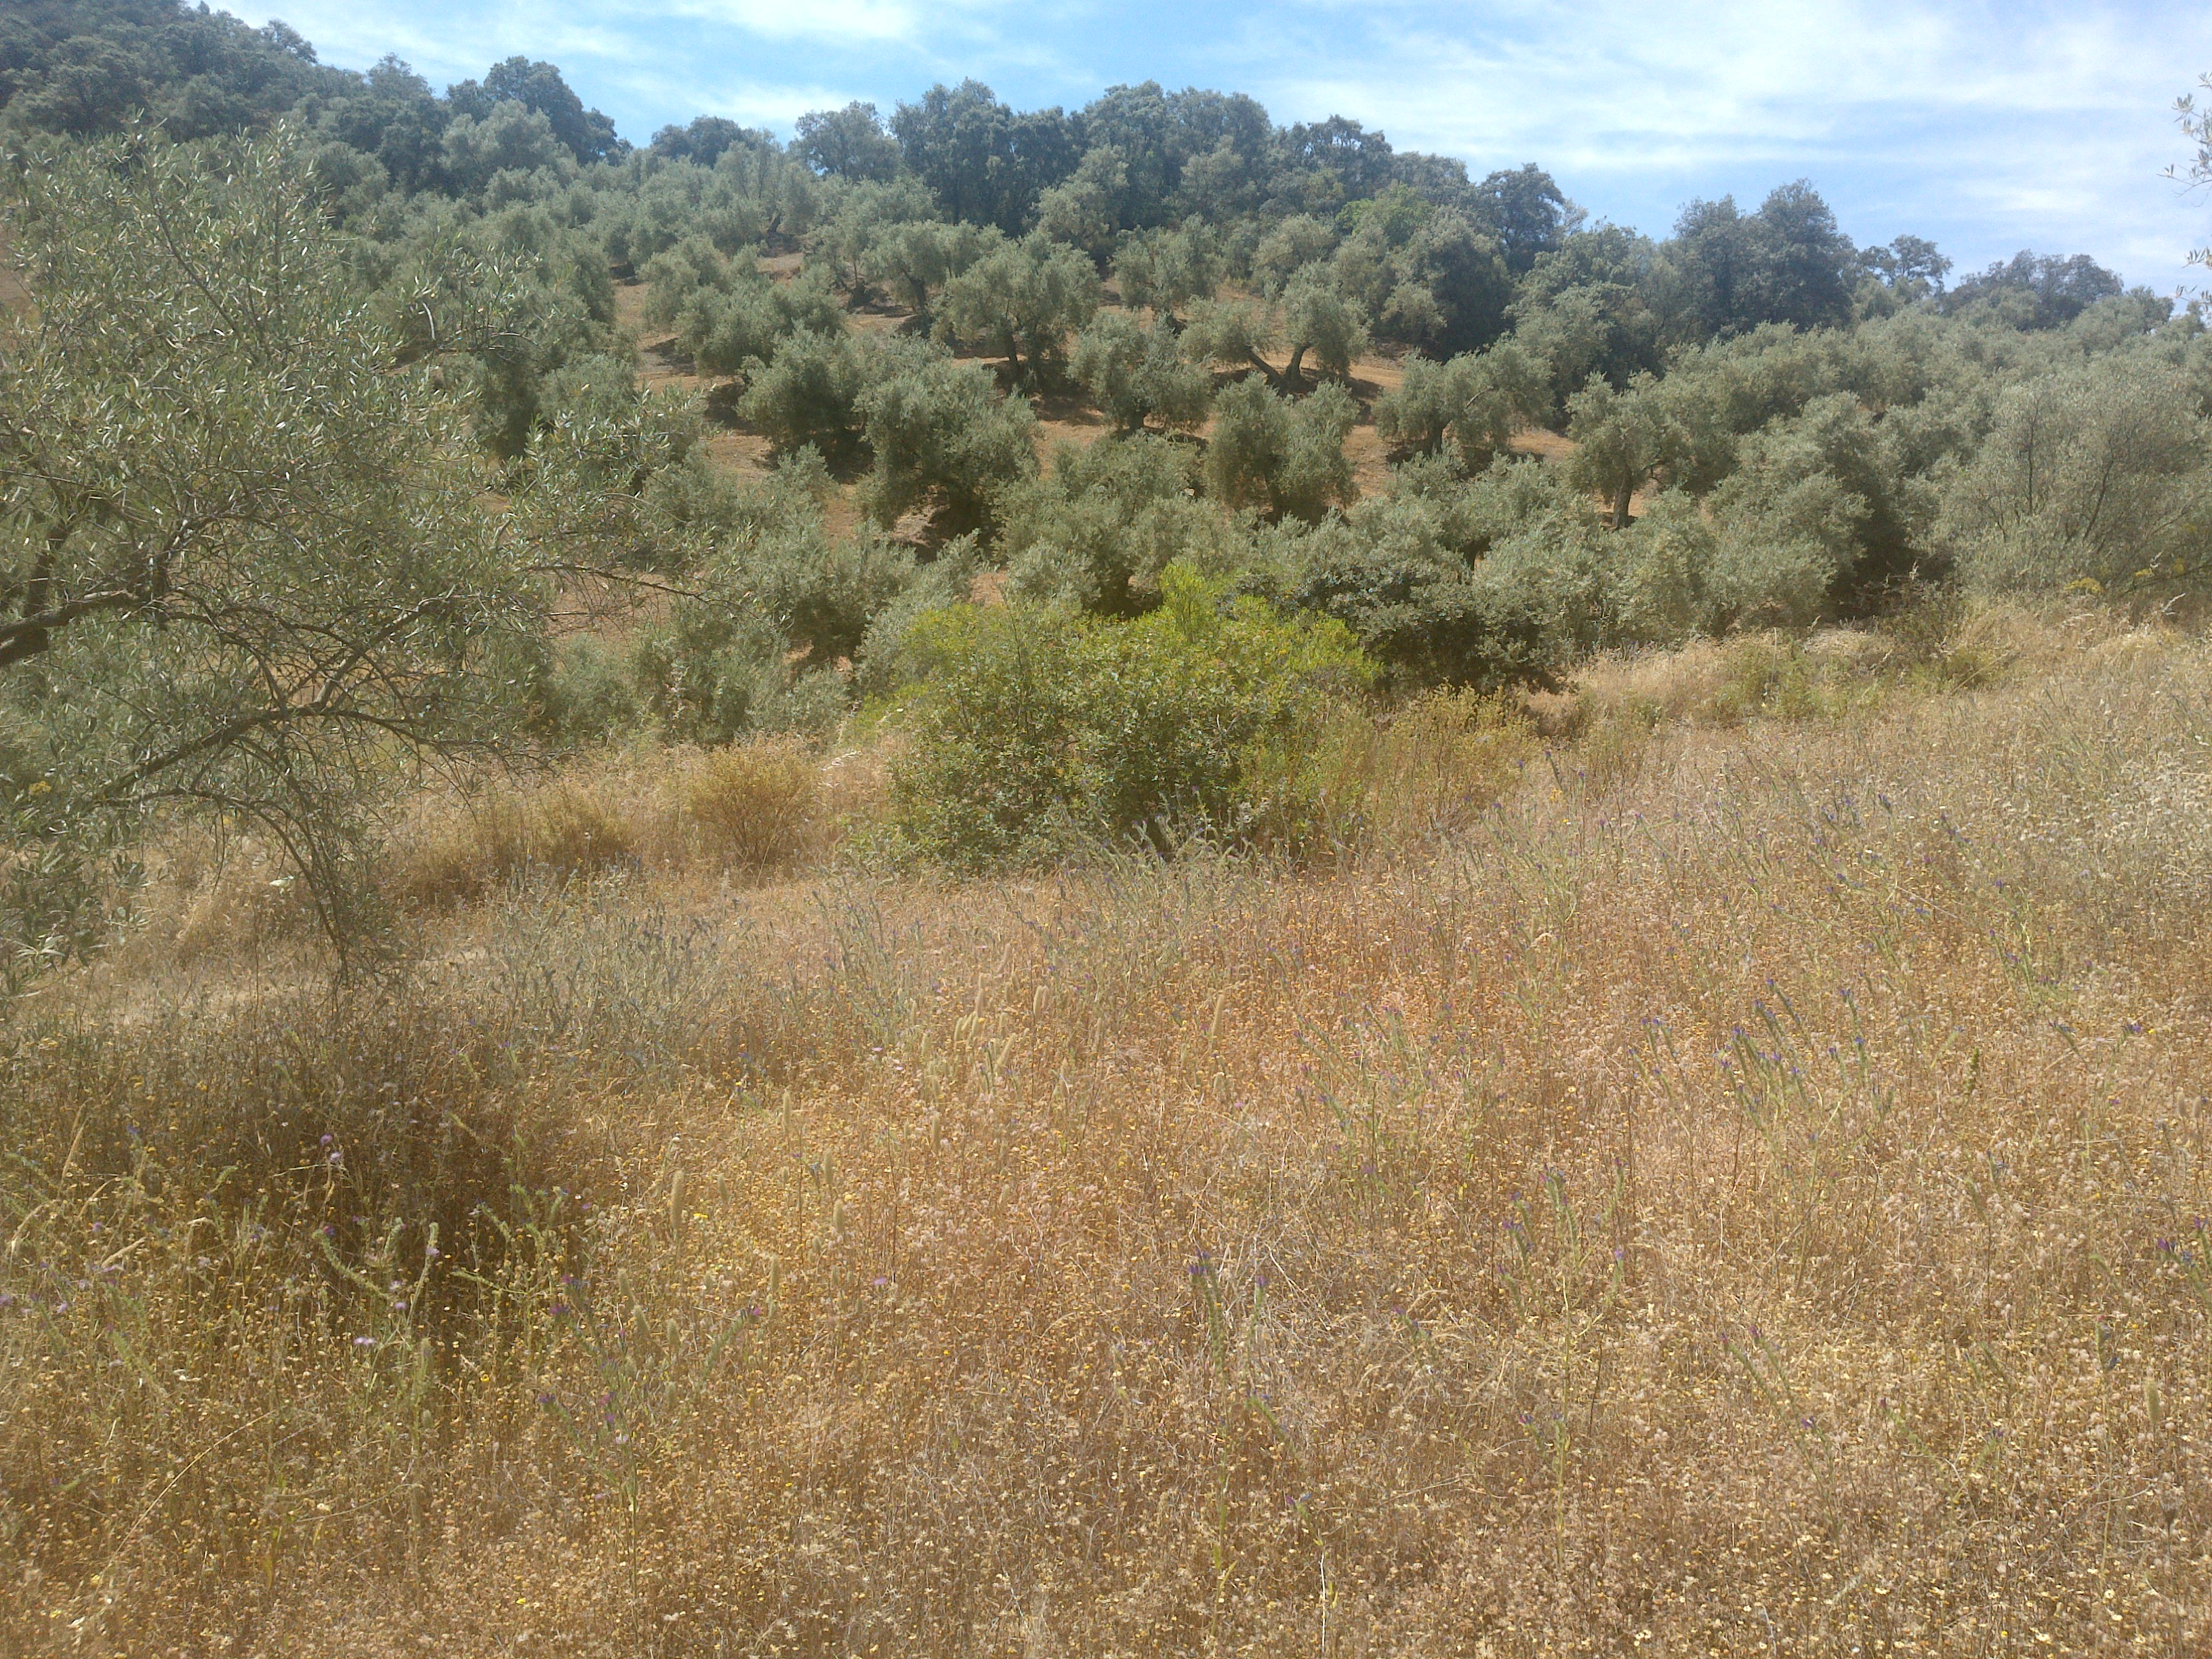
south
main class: Cropland
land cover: Olive groves
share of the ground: 50 - 75 %
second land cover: Spontaneously vegetated surfaces
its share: > 75 %
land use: Agriculture (excluding fallow land and kitchen gardens)
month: May
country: ES
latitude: 38.0459
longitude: -4.4964
